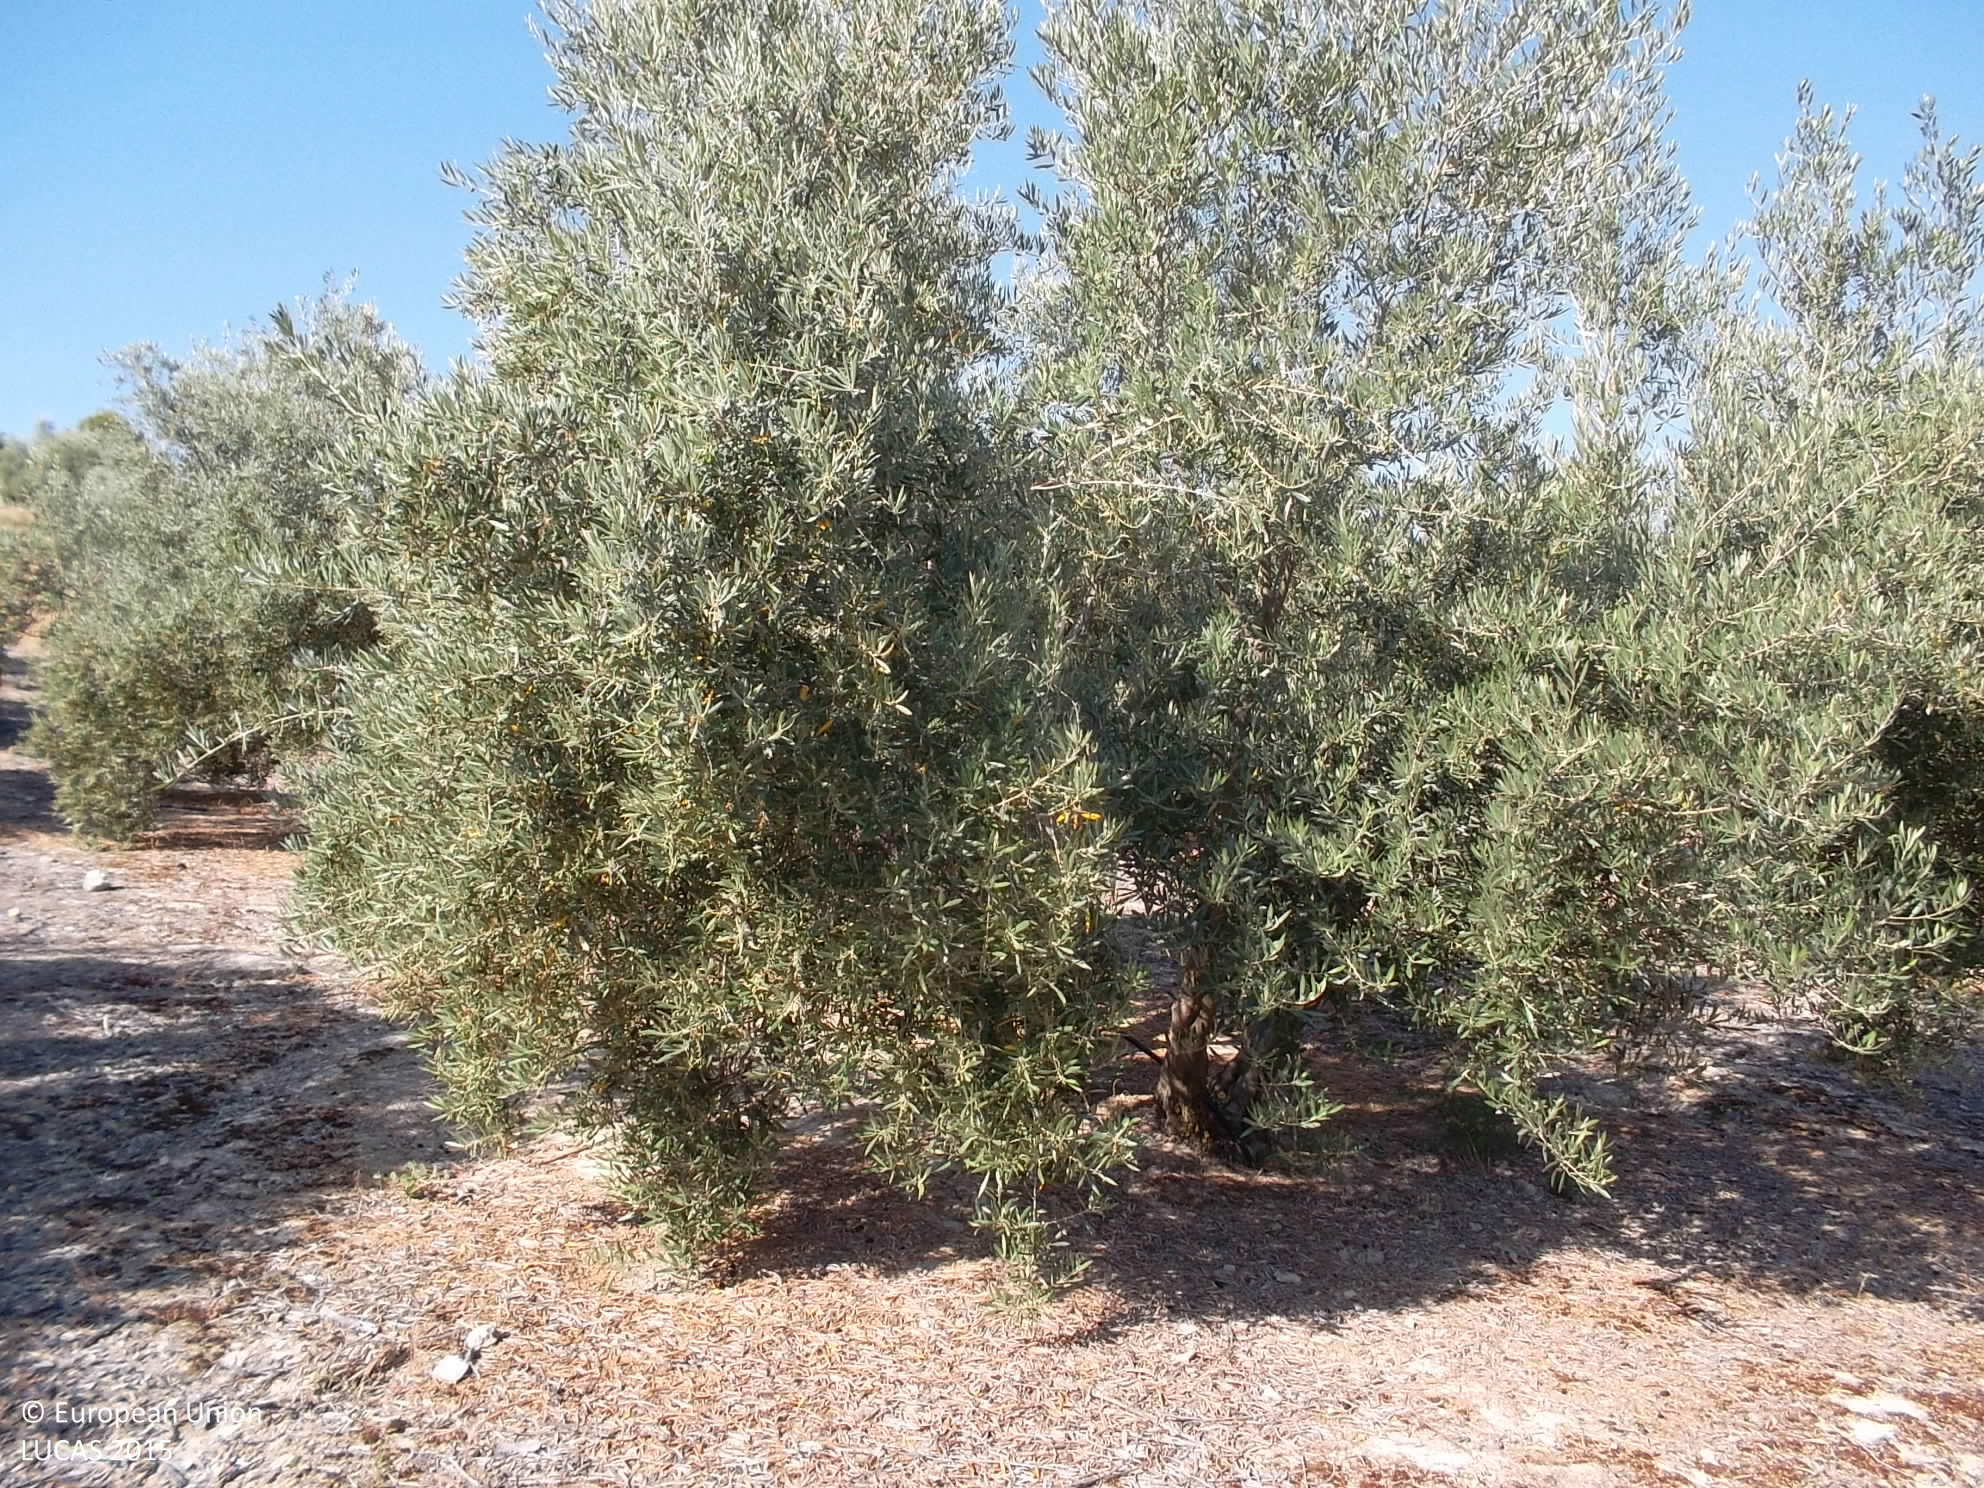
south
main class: Cropland
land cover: Olive groves
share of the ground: 25 - 50 %
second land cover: Other bare soil
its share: > 75 %
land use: Agriculture (excluding fallow land and kitchen gardens)
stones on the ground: 10 - 25 %
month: June
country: ES
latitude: 37.7405
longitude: -3.3295
